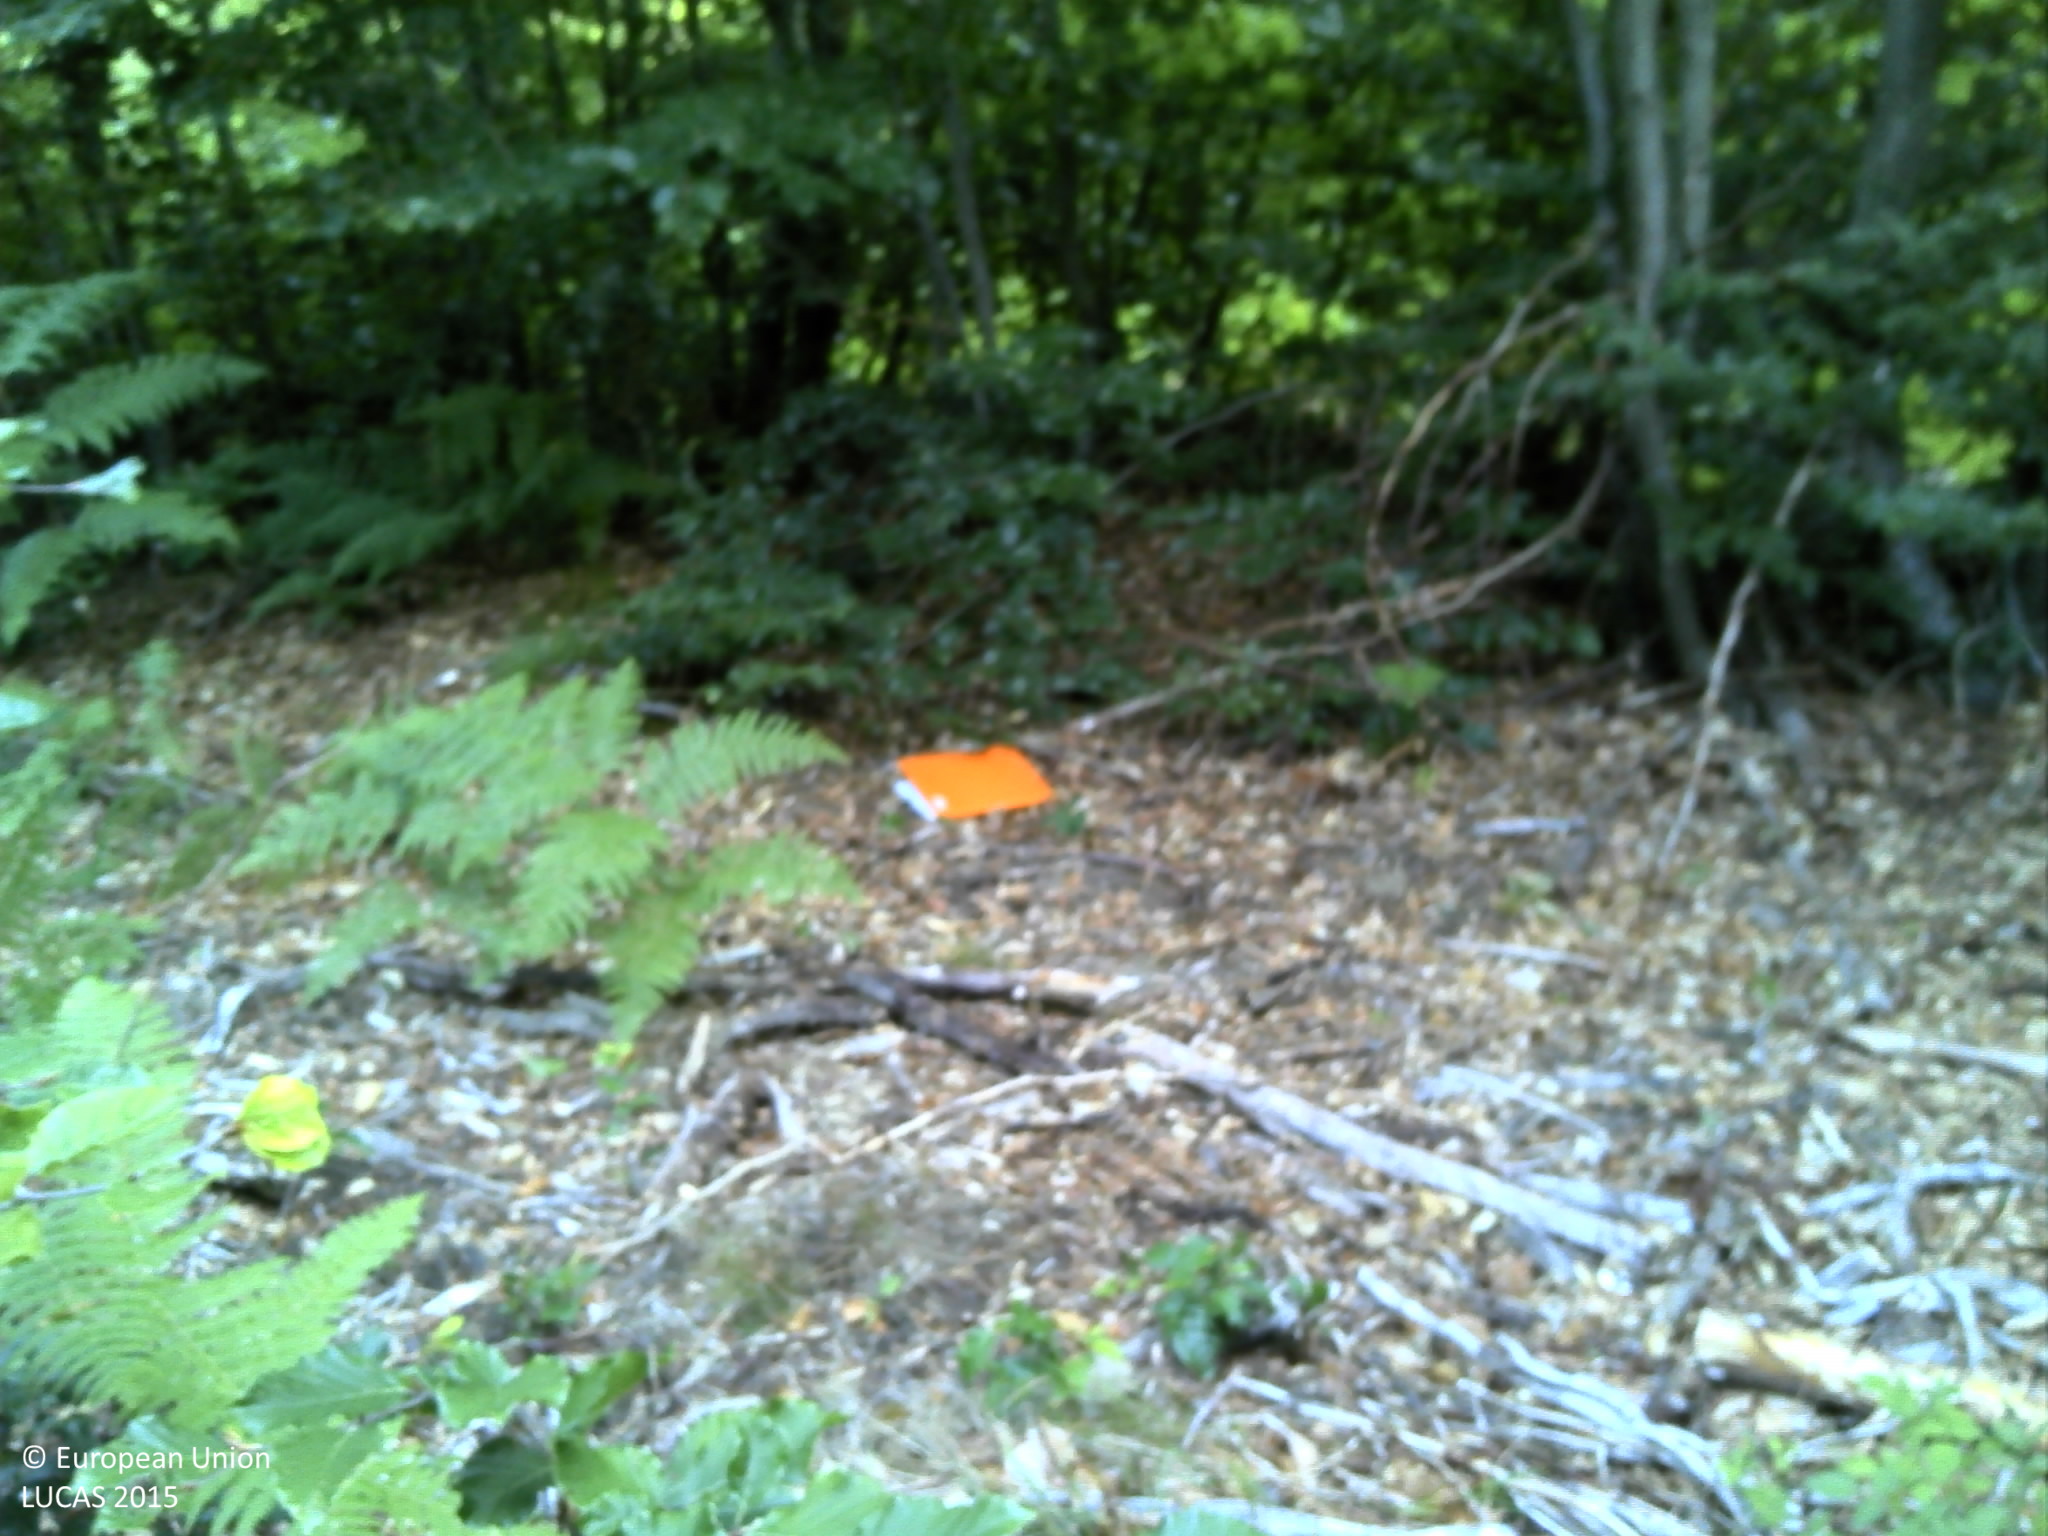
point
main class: Woodland
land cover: Broadleaved woodland
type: beech forest
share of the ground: > 75 %
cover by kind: broadleaved forest trees 90 %, herbaceous plants 5 %, unconsolidated bare surface 5 %
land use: Forestry
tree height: > 5 m
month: July
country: FR
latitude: 48.0294
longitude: 6.1251
